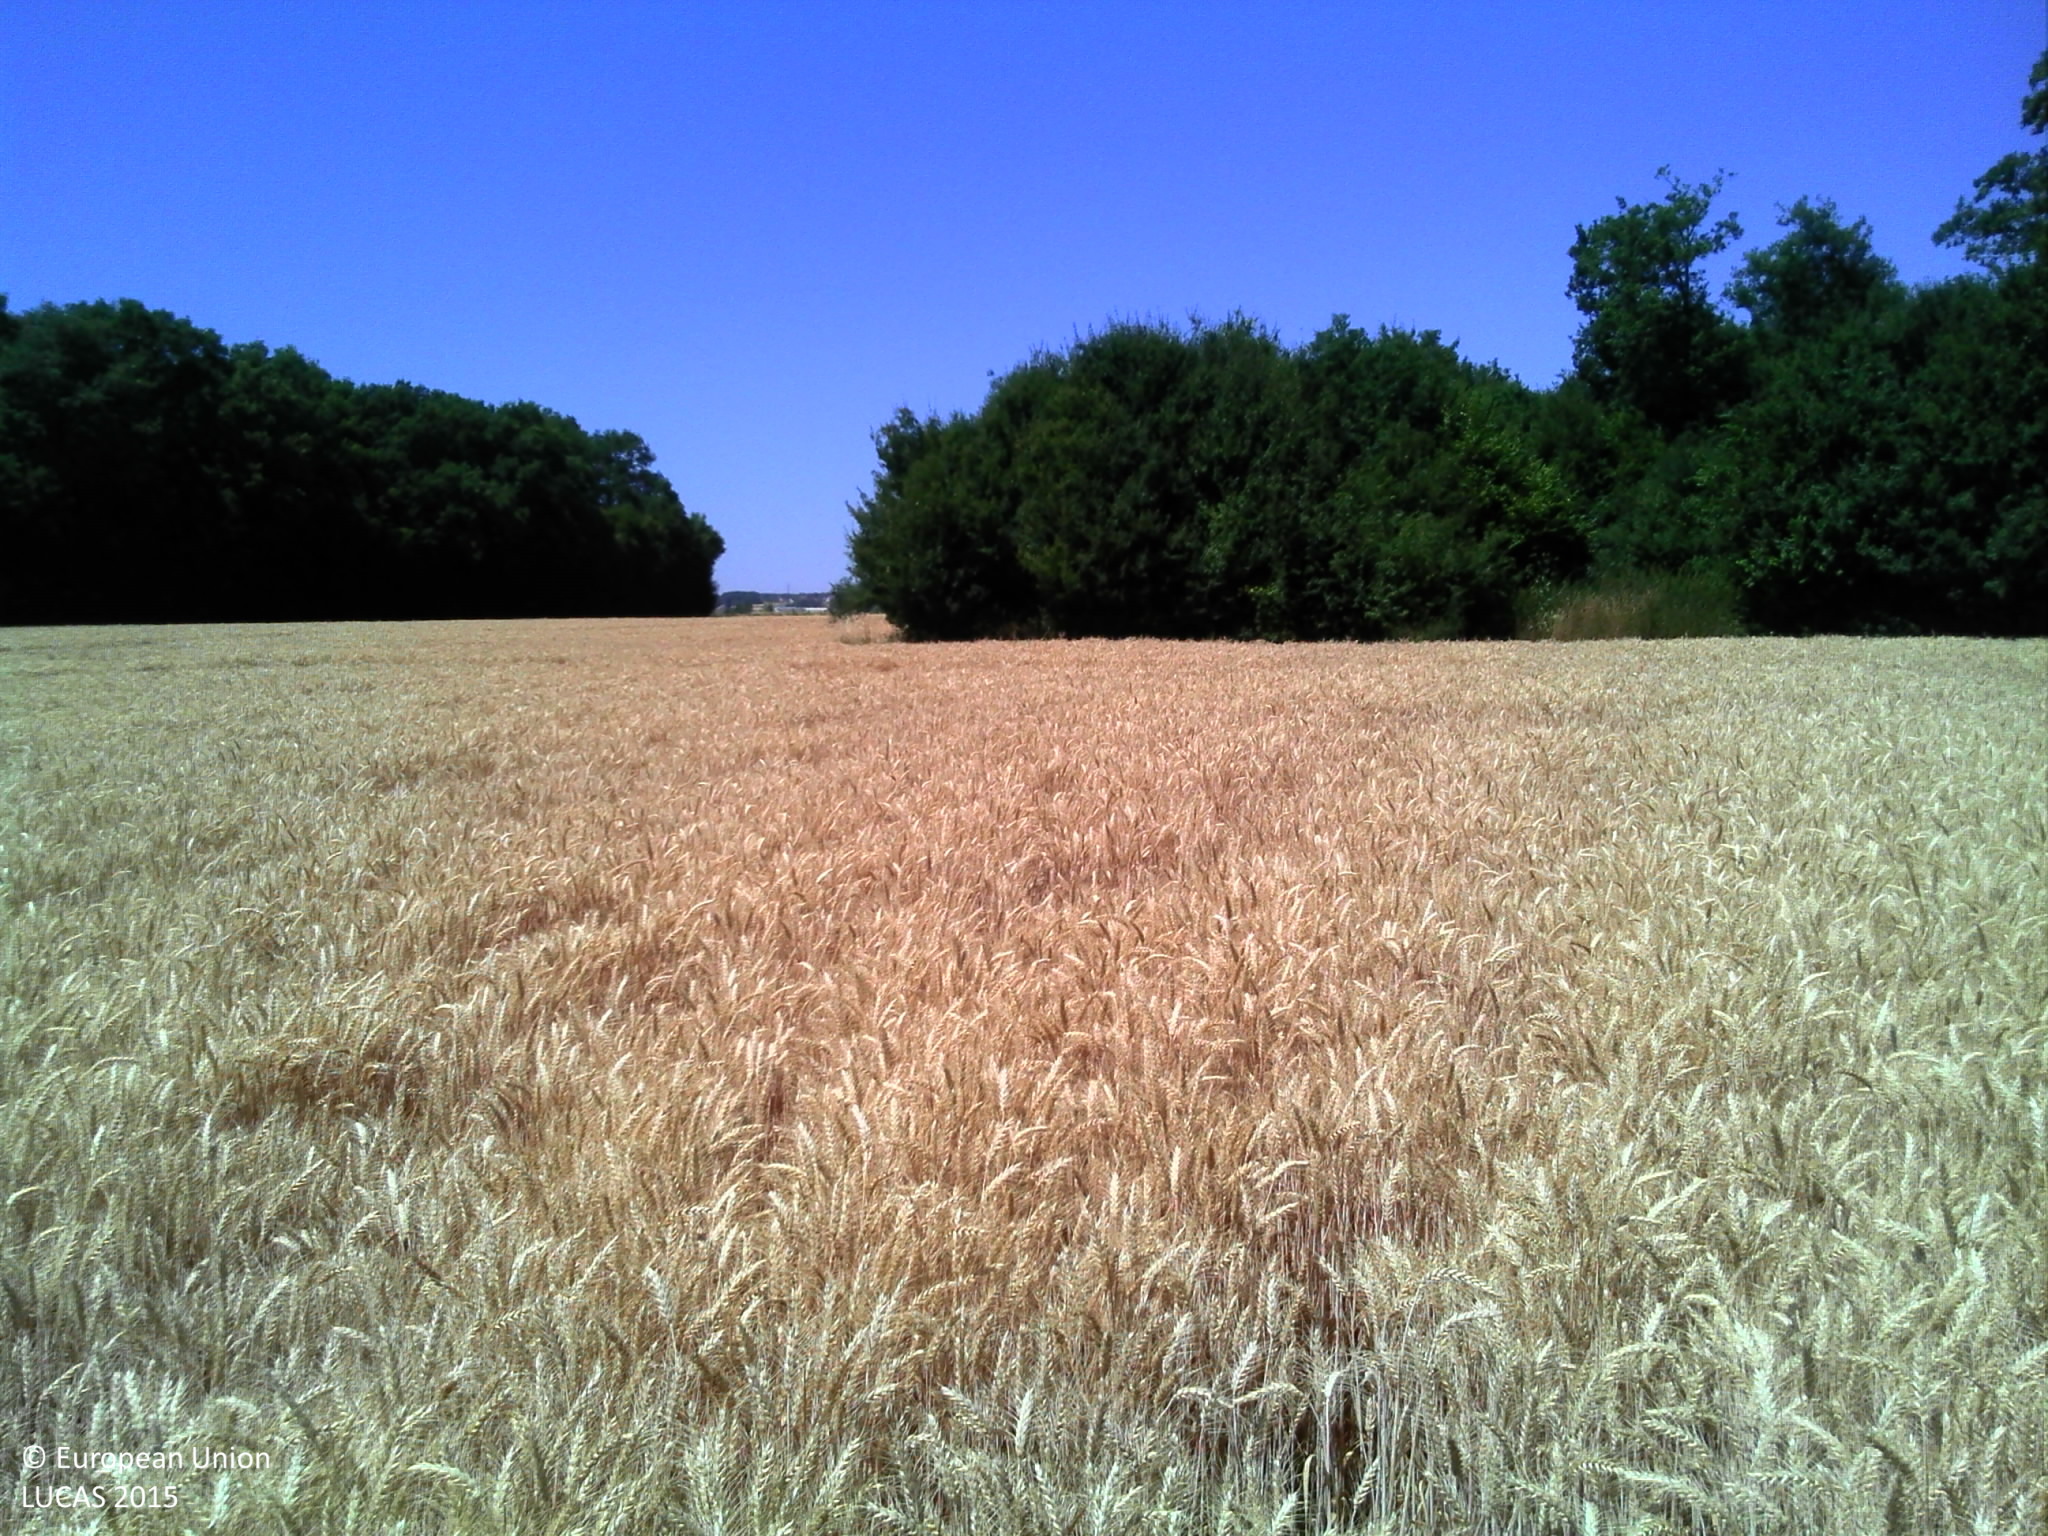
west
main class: Cropland
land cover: Common wheat
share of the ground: > 75 %
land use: Agriculture (excluding fallow land and kitchen gardens)
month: July
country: FR
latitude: 48.0378
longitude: 2.4659
